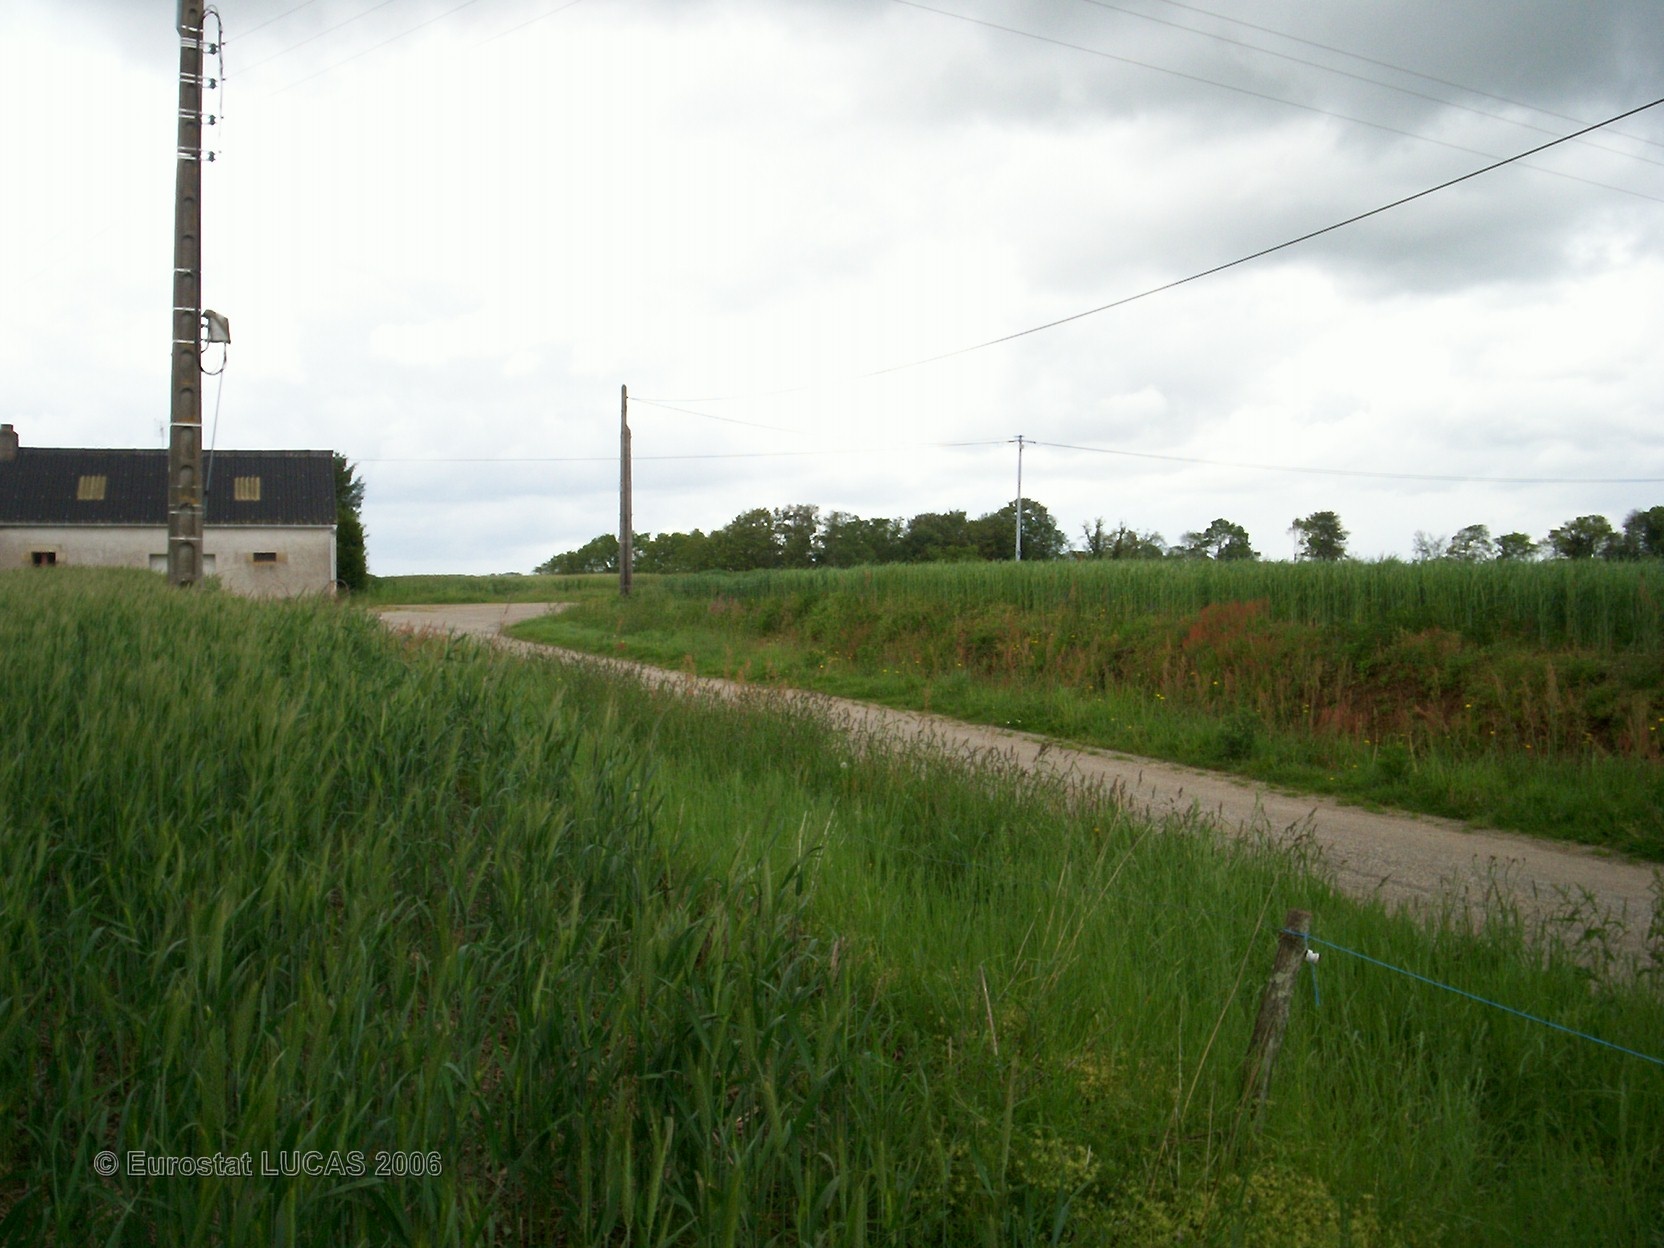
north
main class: Cropland
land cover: Common wheat
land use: Agriculture (excluding fallow land and kitchen gardens)
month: May
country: FR
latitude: 48.0733
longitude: -3.5669
